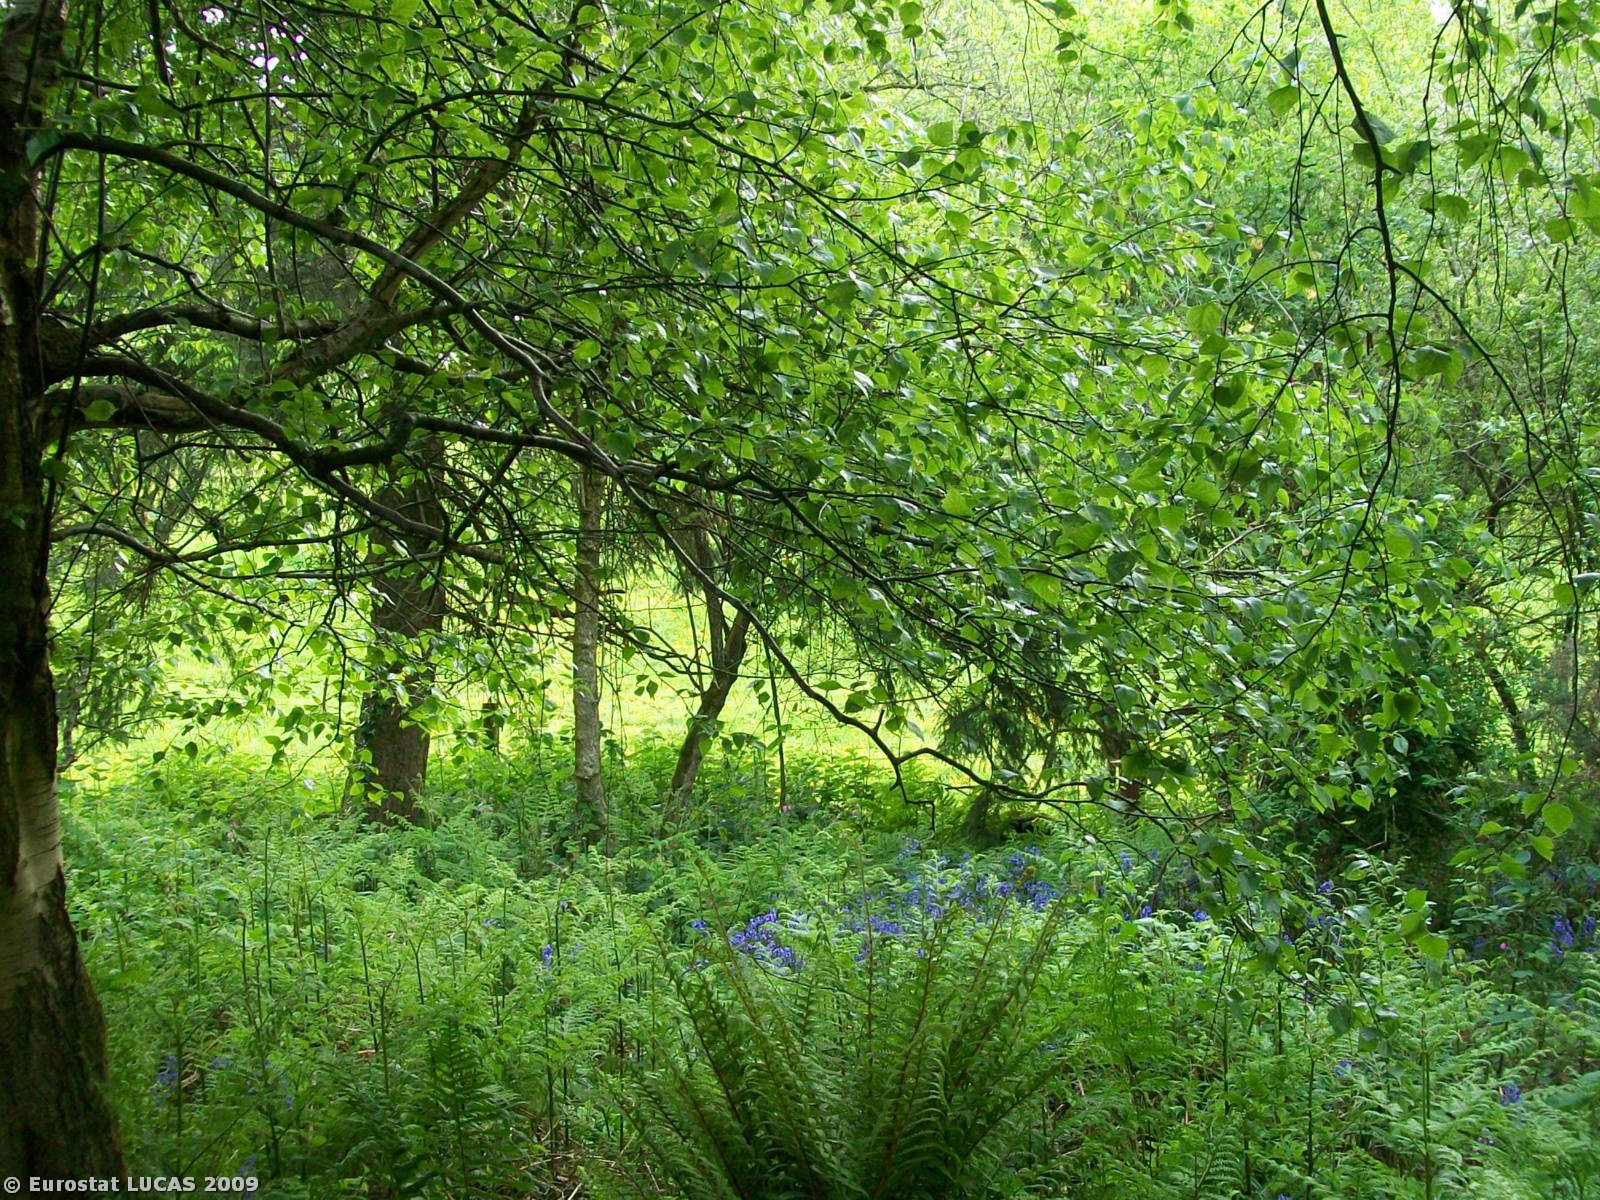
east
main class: Woodland
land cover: Broadleaved woodland
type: mesophytic deciduous forest
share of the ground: > 75 %
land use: Unused
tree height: > 5 m
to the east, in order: Broadleaved woodland; Fences; Grassland without tree/shrub cover; Fences; Spontaneously vegetated surfaces; Paved roads, cycling and walking lanes; Spontaneously vegetated surfaces; Managed hedges; Coniferous woodland; Broadleaved woodland
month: May
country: GB
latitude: 51.0245
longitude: -2.1363
